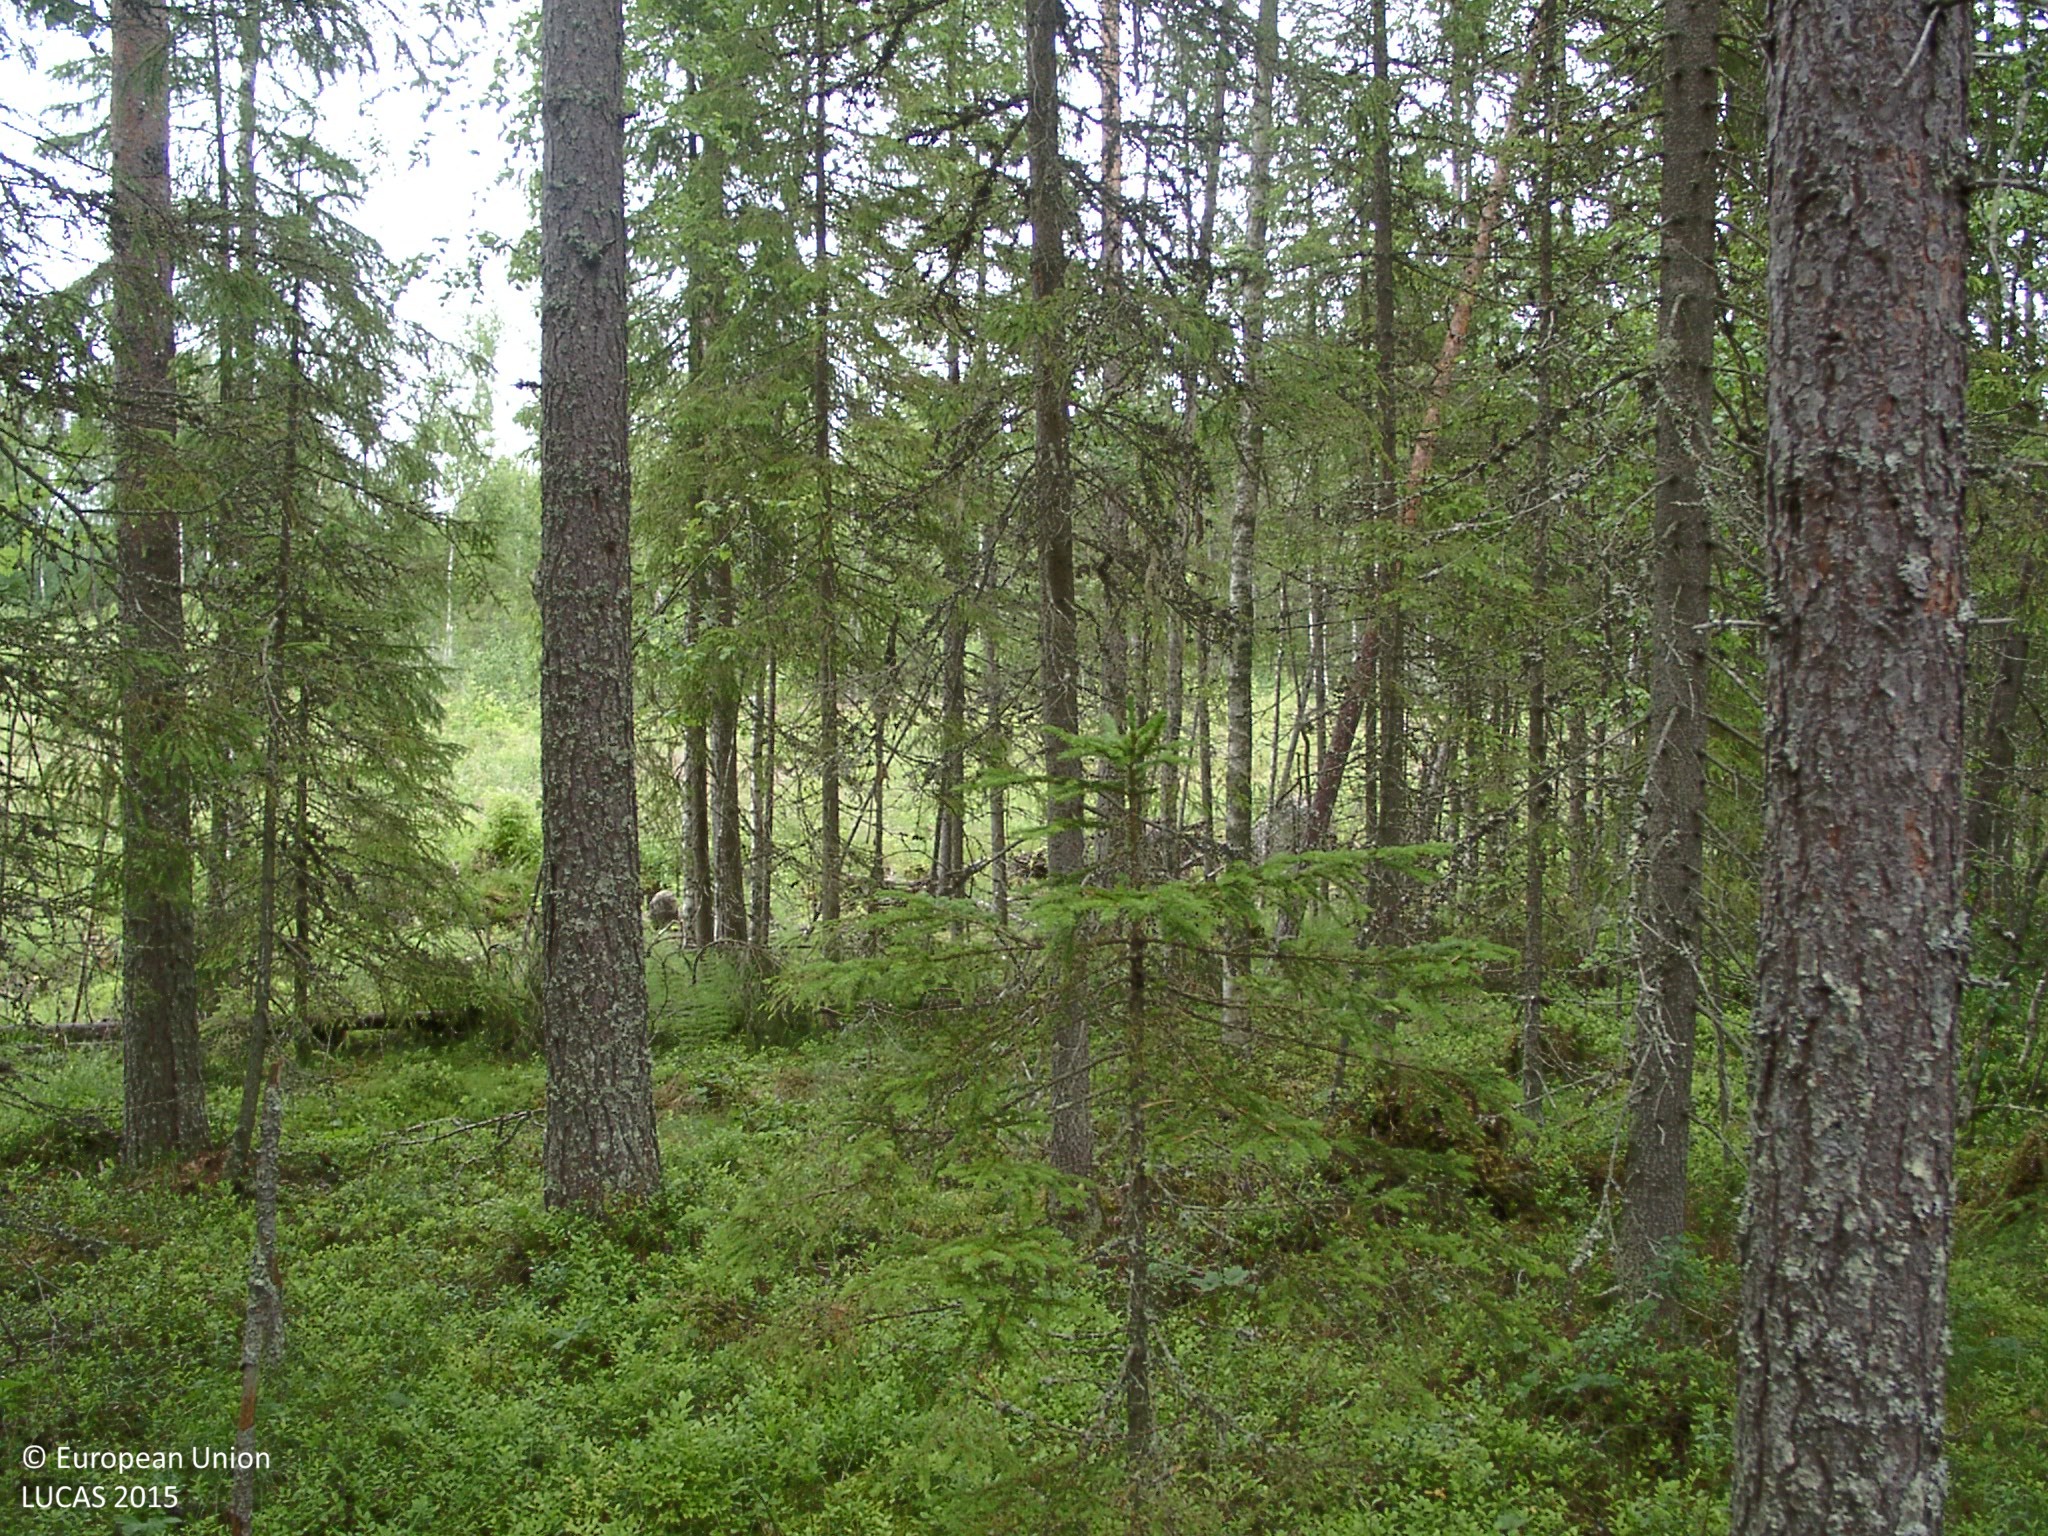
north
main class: Woodland
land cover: Other mixed woodland
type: boreal forest
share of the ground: > 75 %
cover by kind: coniferous forest trees 50 %, broadleaved forest trees 25 %, shrubs 10 %, lichens and mosses 10 %, herbaceous plants 5 %
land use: Semi-natural and natural areas not in use
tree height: > 5 m
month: July
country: FI
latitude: 62.1484
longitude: 25.3658
